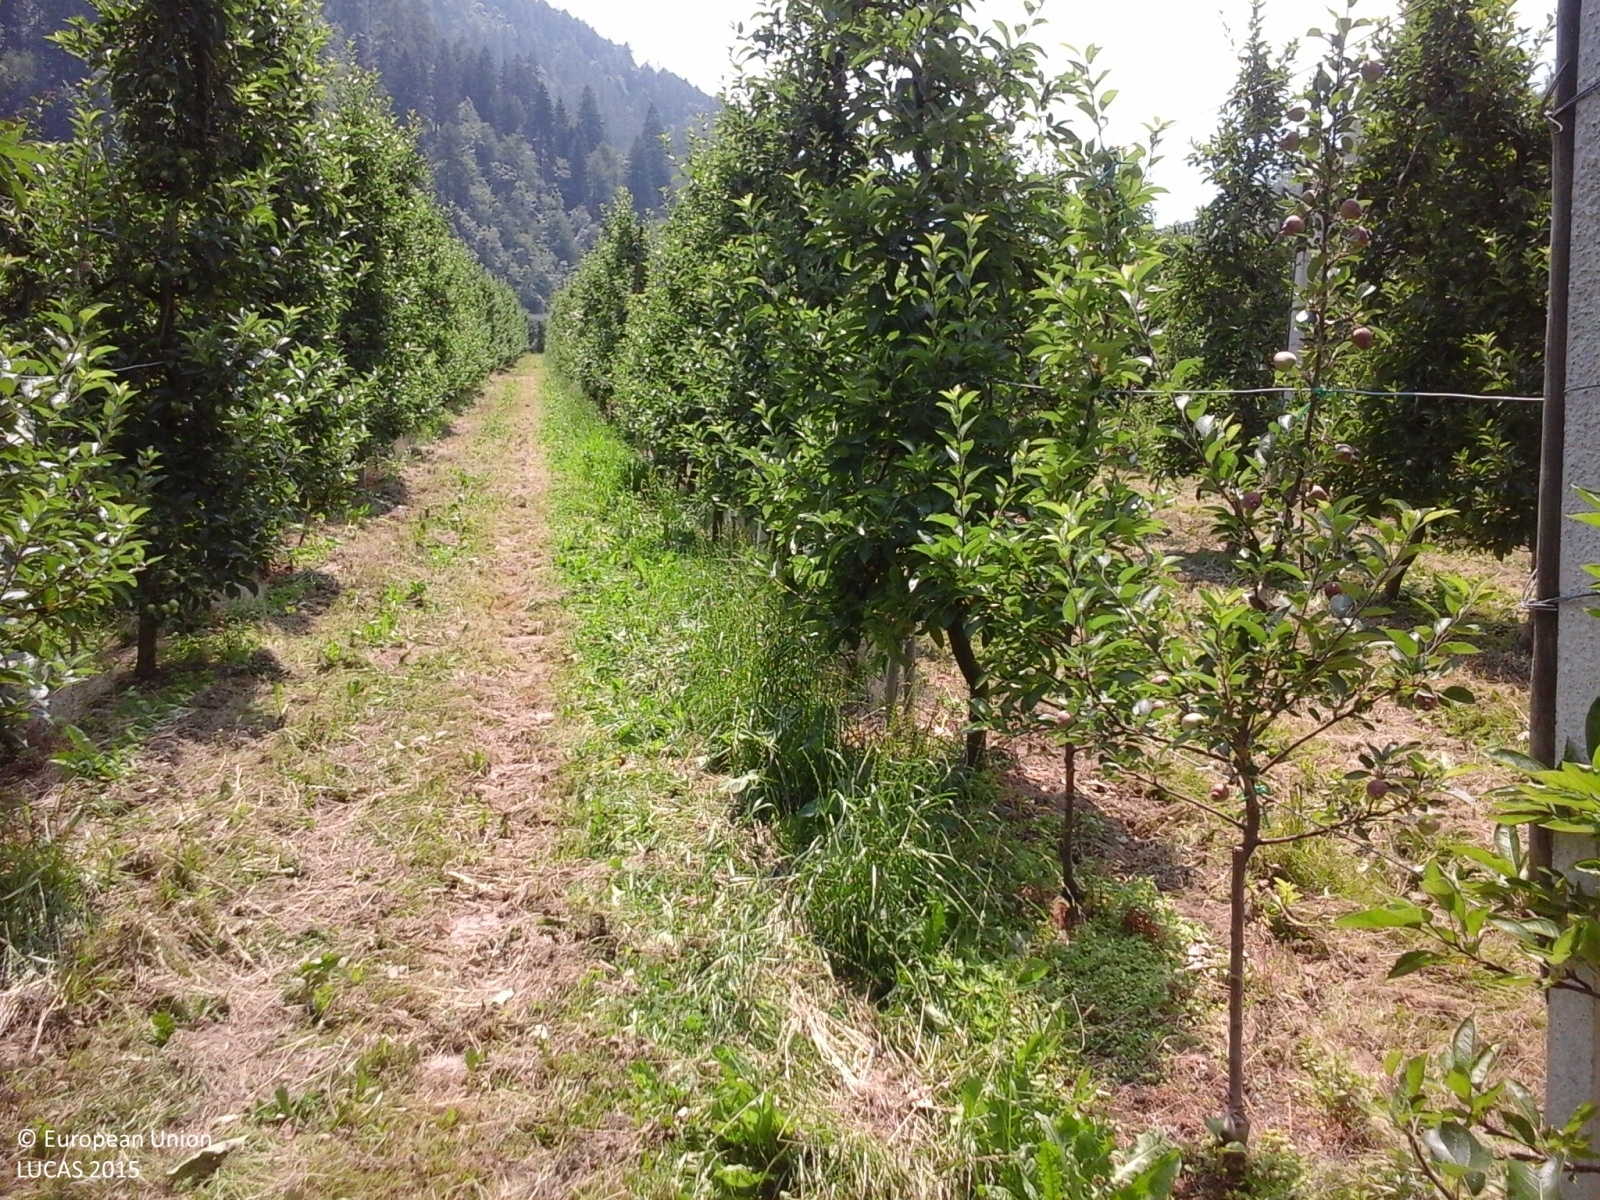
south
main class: Cropland
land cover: Apple fruit
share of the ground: > 75 %
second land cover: Grassland without tree/shrub cover
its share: > 75 %
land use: Agriculture (excluding fallow land and kitchen gardens)
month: June
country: IT
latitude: 46.7048
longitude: 11.1889
